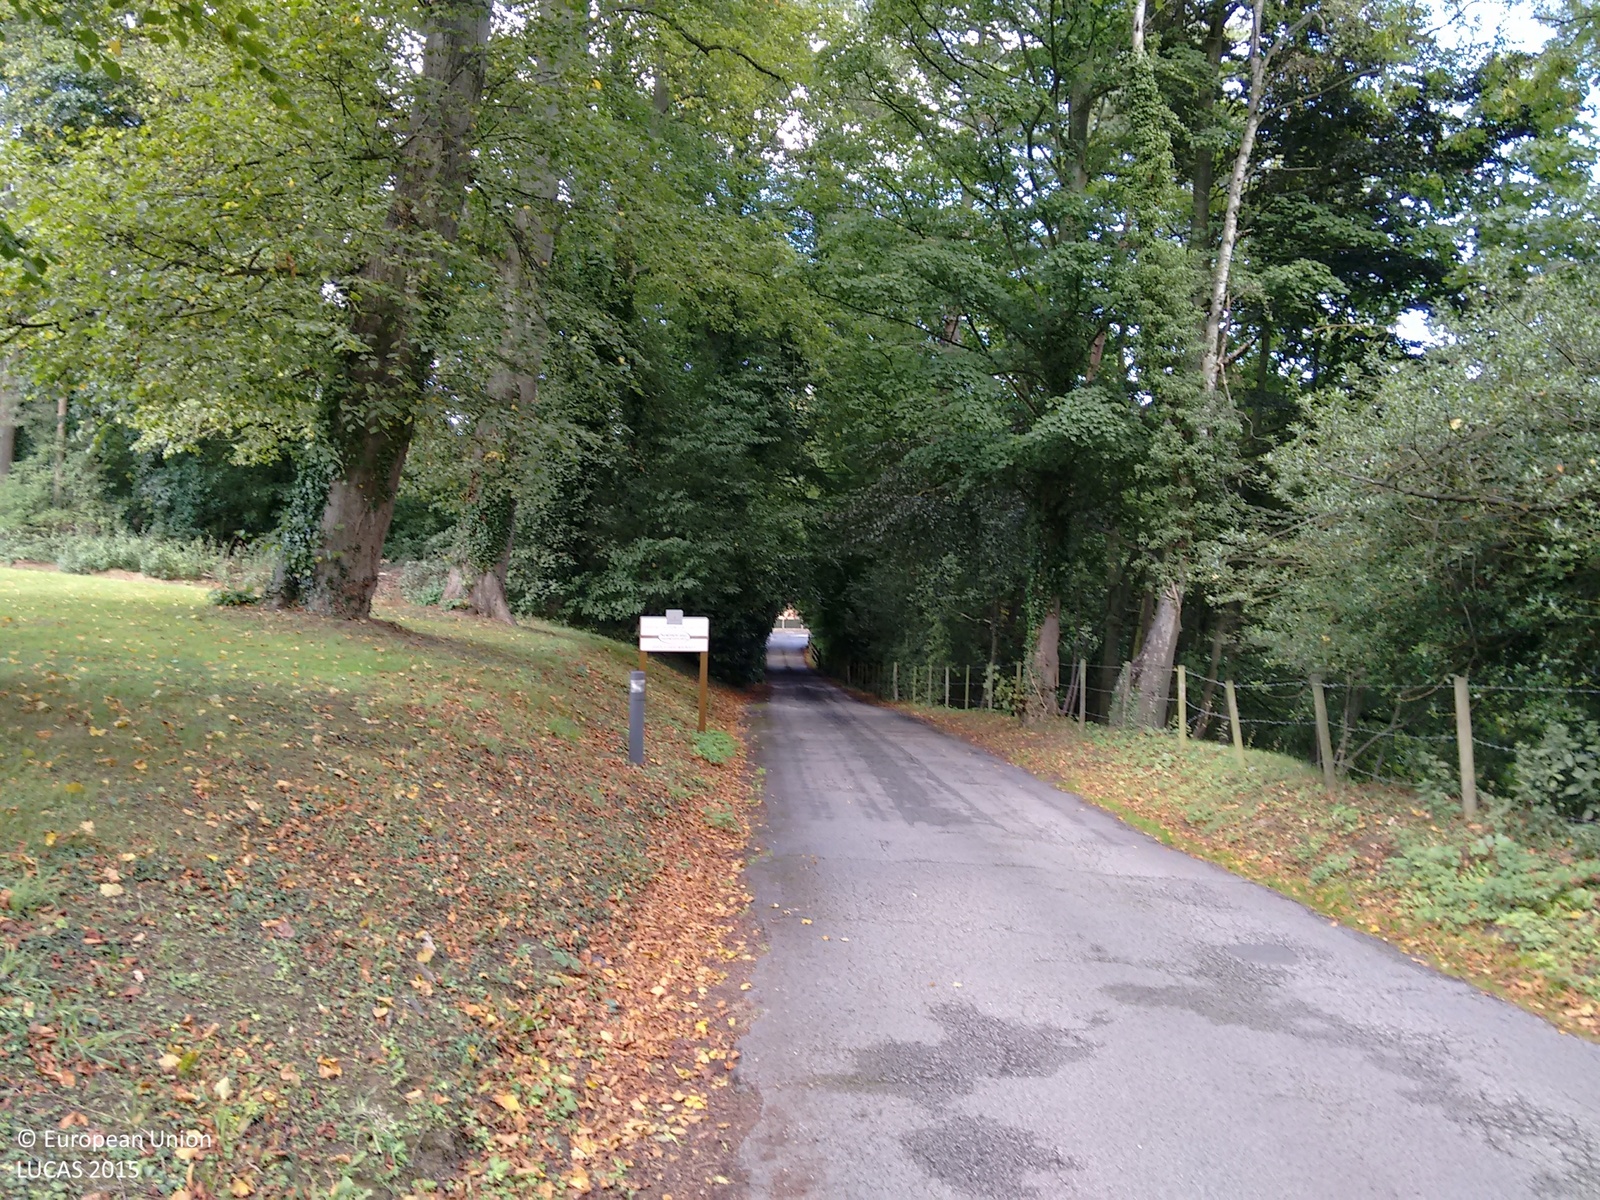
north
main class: Grassland
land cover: Grassland without tree/shrub cover
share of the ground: > 75 %
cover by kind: herbaceous plants 100 %
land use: Commerce
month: September
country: GB
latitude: 53.1983
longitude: -3.0844
